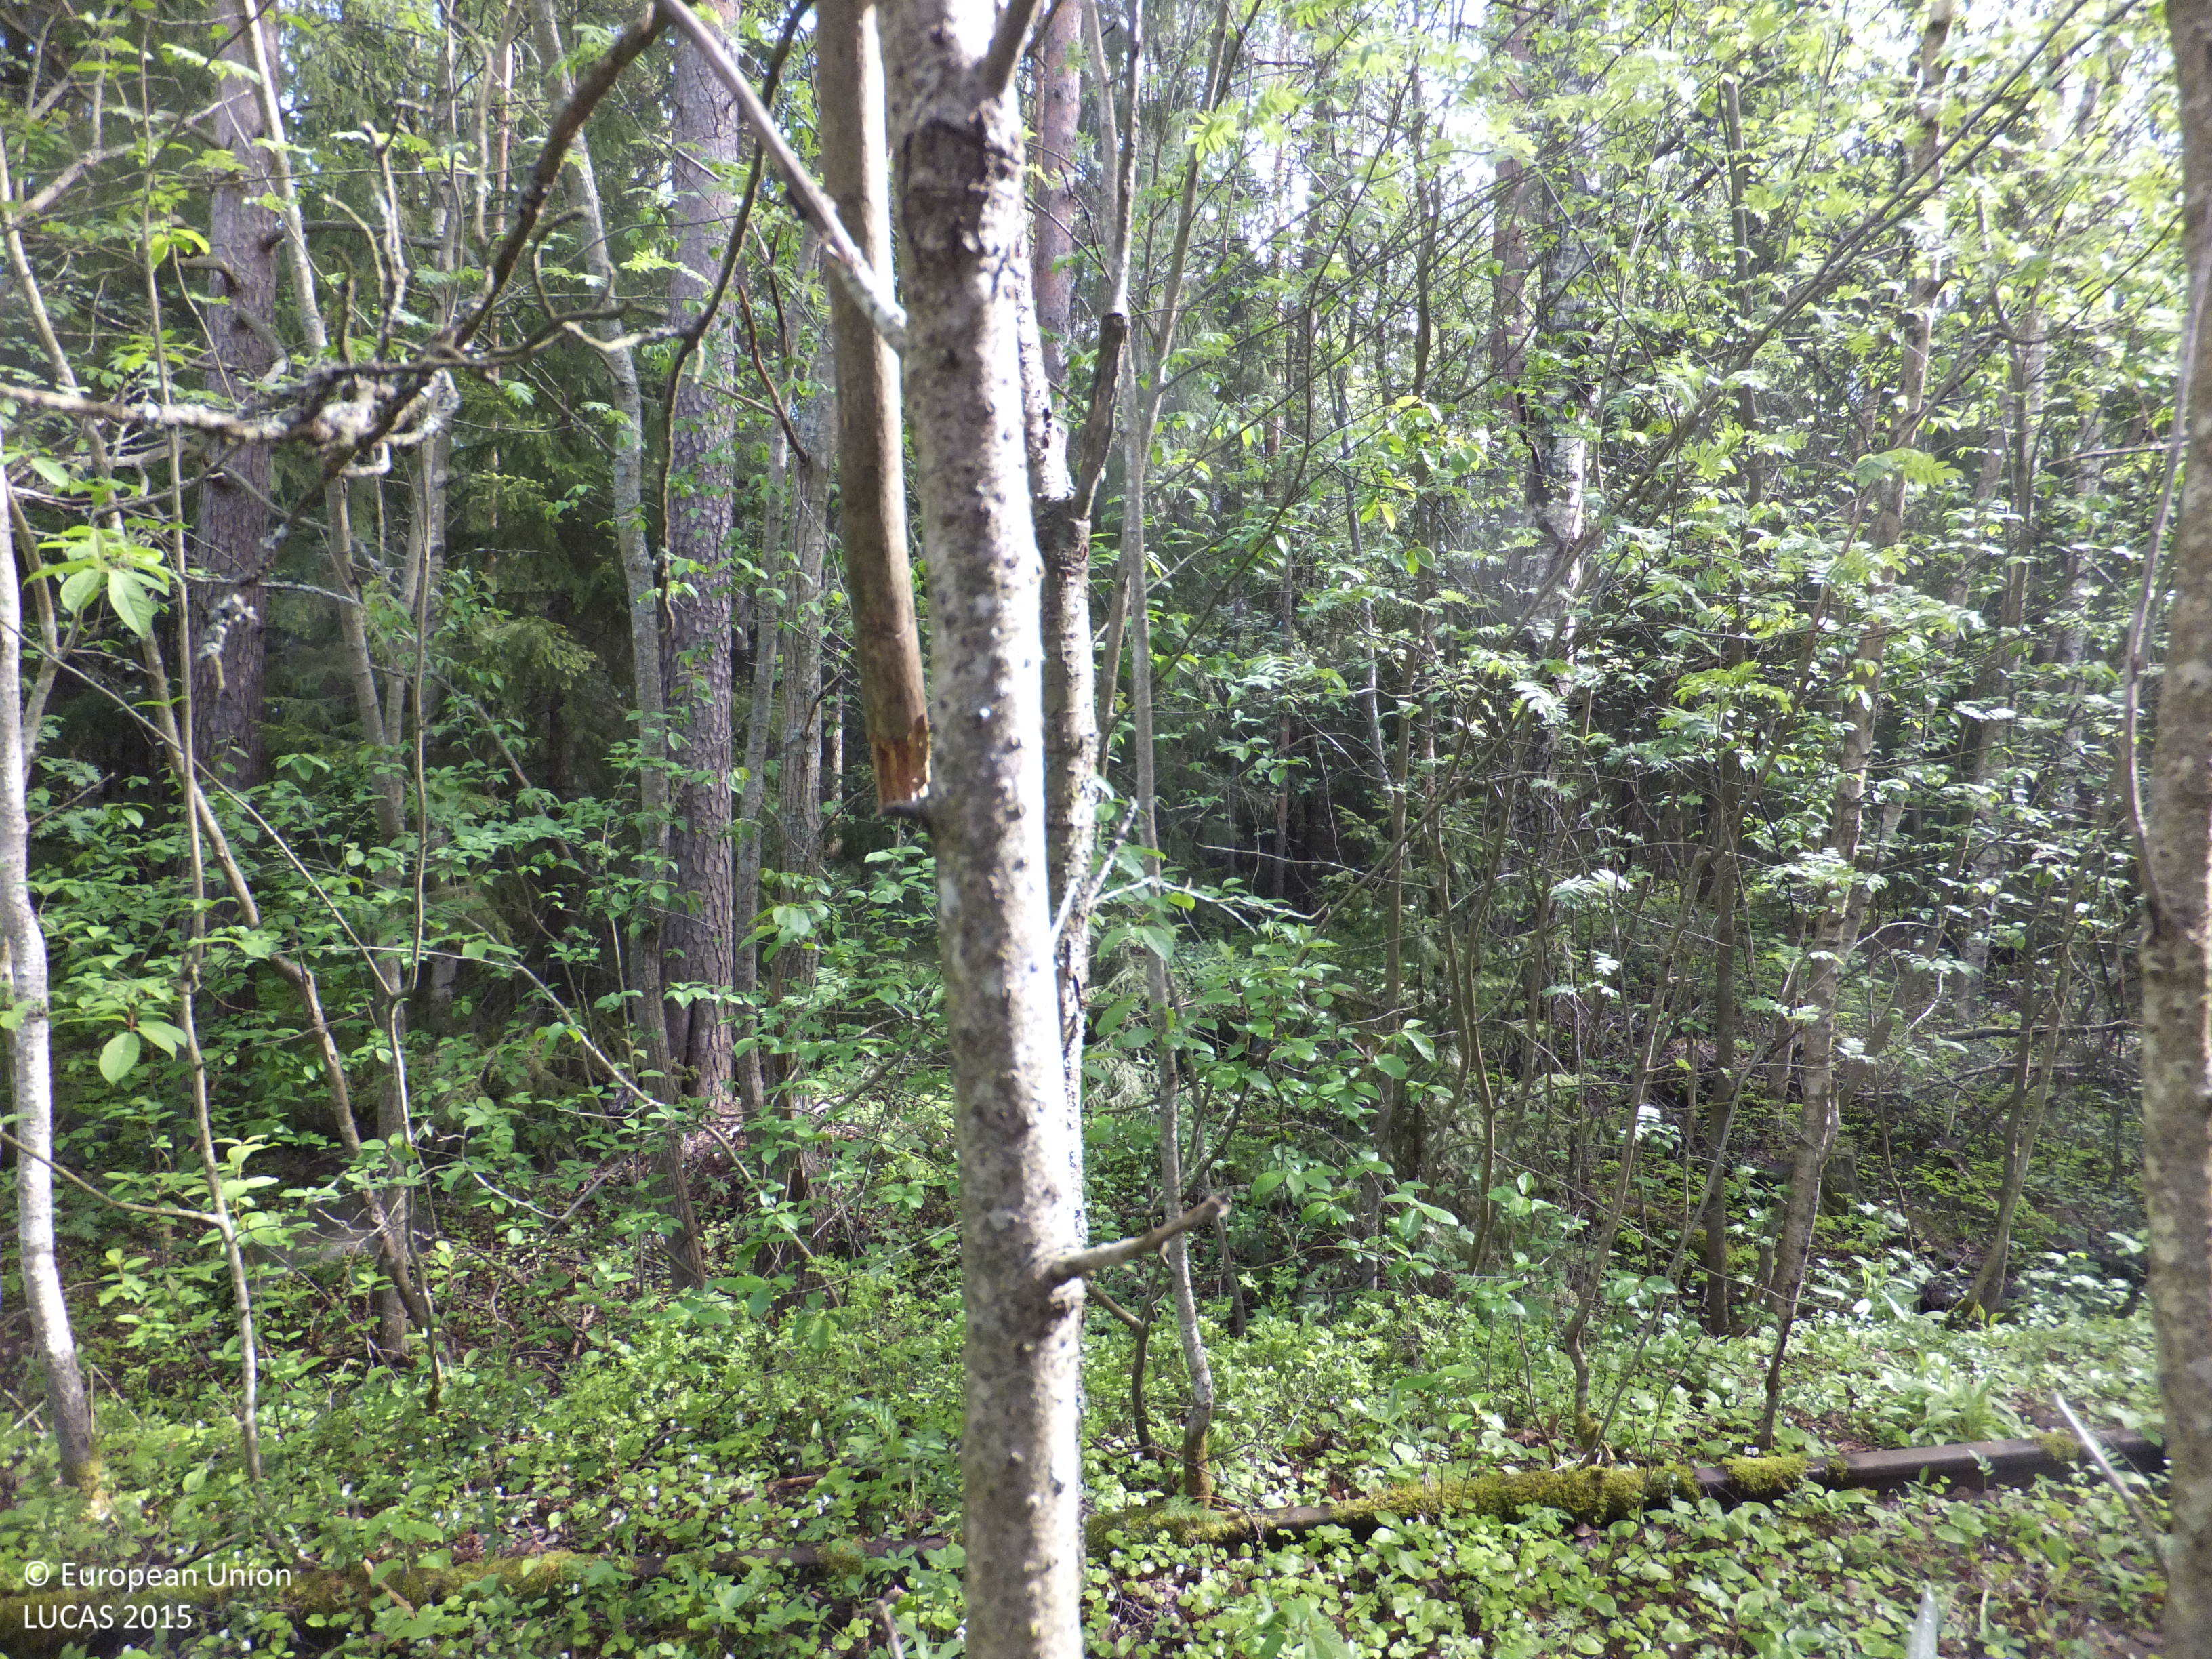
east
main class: Woodland
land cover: Other mixed woodland
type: boreal forest
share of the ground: > 75 %
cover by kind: broadleaved forest trees 70 %, coniferous forest trees 30 %
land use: Semi-natural and natural areas not in use
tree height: > 5 m
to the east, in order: Other mixed woodland; Tracks; Fences; Grass margins; Artificial constructions in urban areas
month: May
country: FI
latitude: 63.6643
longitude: 22.7165
